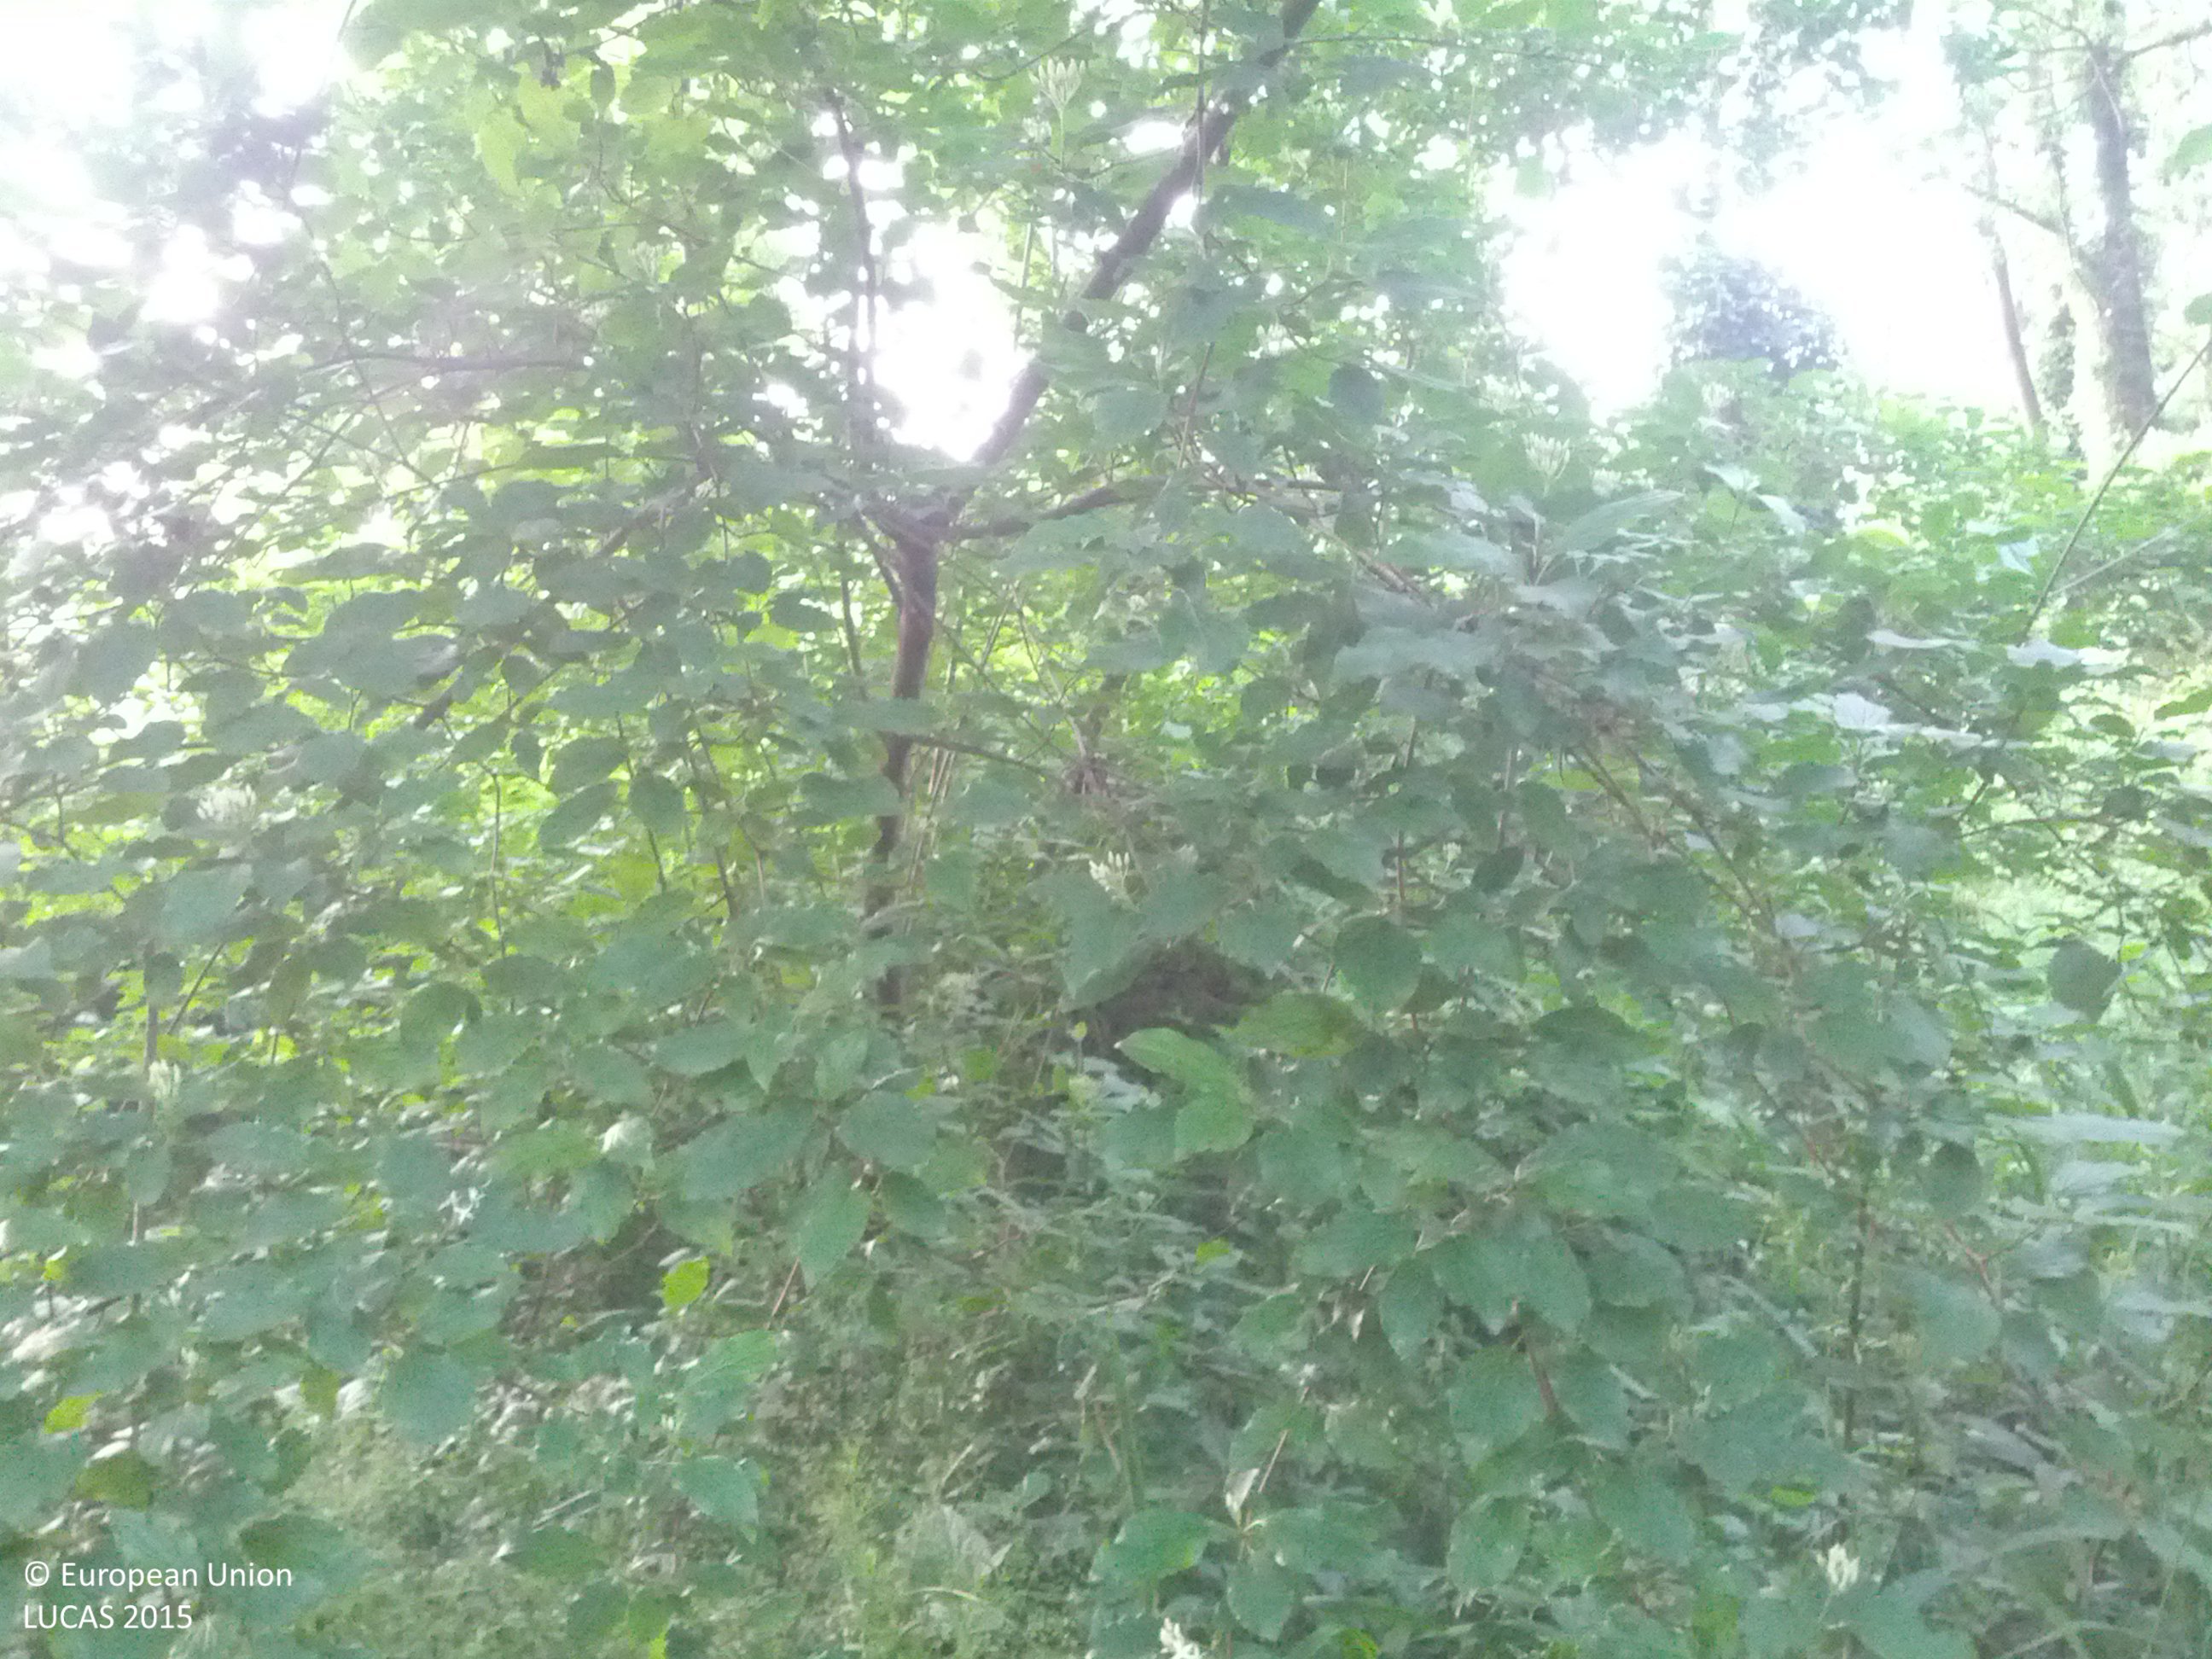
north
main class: Woodland
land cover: Broadleaved woodland
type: floodplain forest
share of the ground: 50 - 75 %
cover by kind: broadleaved forest trees 50 %, herbaceous plants 35 %, shrubs 15 %
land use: Forestry
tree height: > 5 m
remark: Temporary flooded
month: May
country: AT
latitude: 48.3319
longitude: 16.3044
